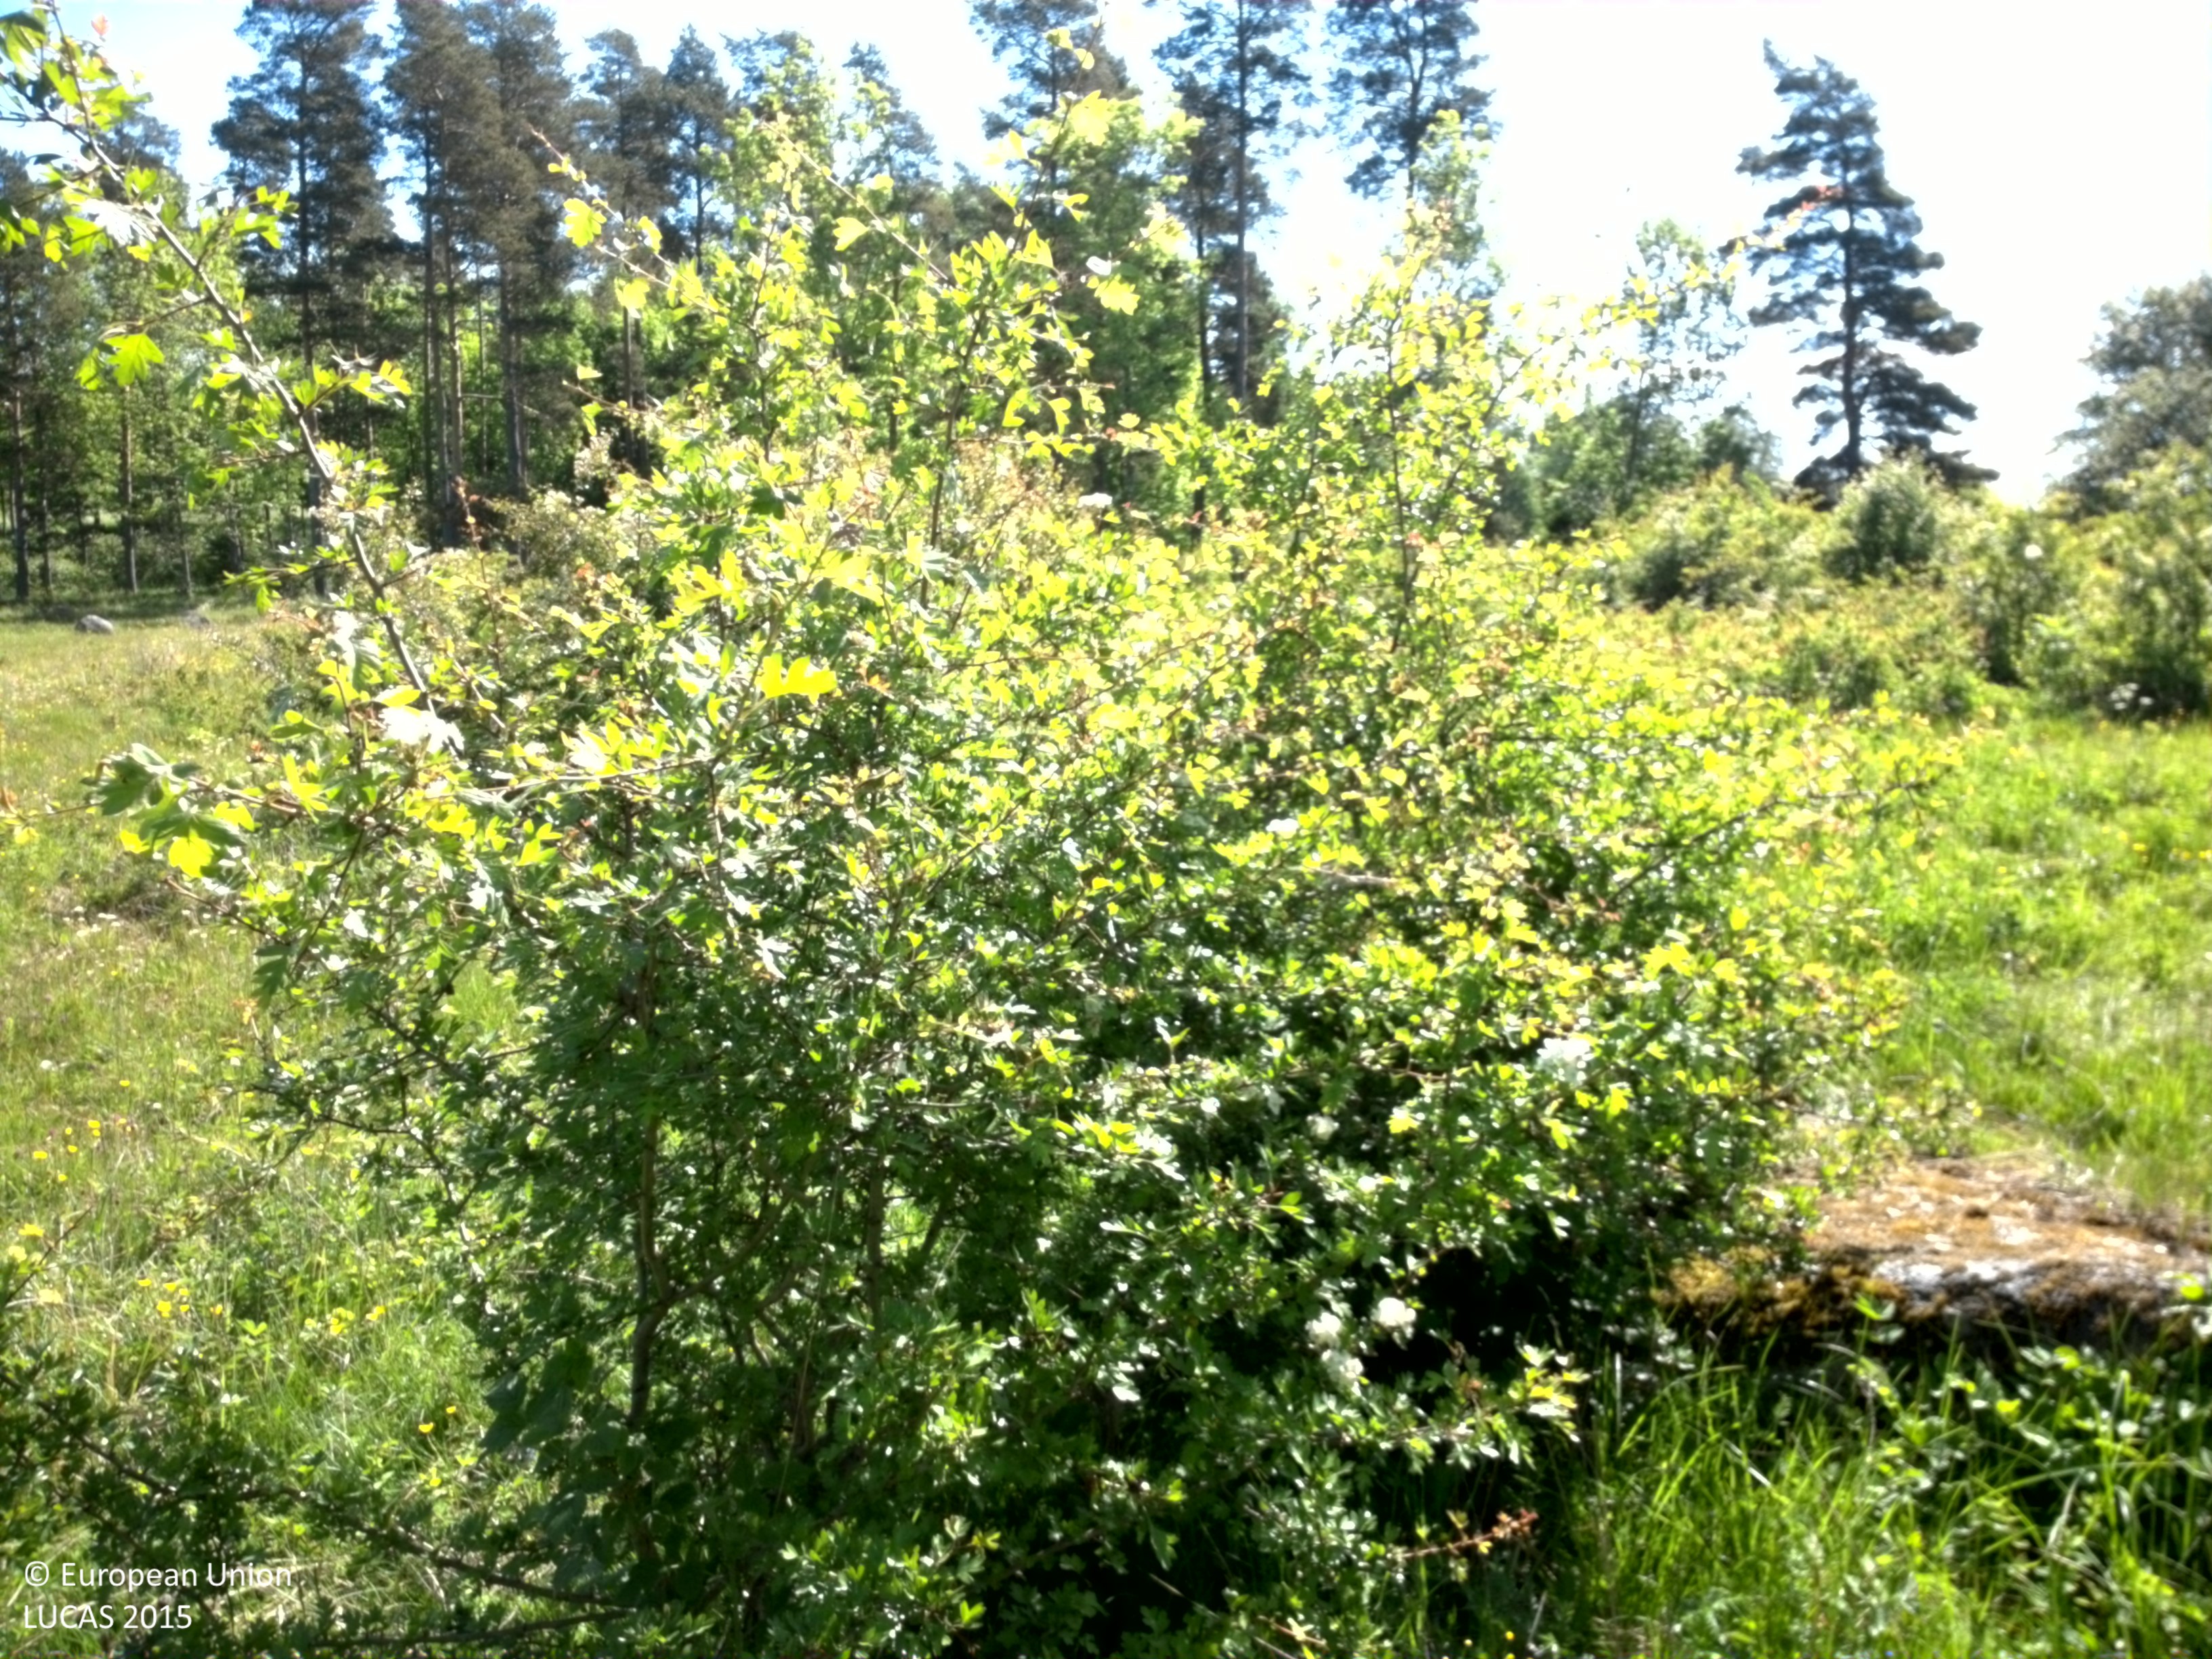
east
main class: Shrubland
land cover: Shrubland with sparse tree cover
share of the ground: 25 - 50 %
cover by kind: herbaceous plants 70 %, shrubs 25 %, broadleaved forest trees 5 %
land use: Agriculture (excluding fallow land and kitchen gardens)
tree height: > 5 m
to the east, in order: Shrubland with sparse tree cover; Electric lines; Shrubland without tree cover; Other mixed woodland; Tracks; Other mixed woodland; Dry stone walls; Broadleaved woodland; Fences; Artificial constructions in urban areas; Fences; Broadleaved woodland; Grassland with sparse tree/shrub cover
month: June
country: SE
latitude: 58.4706
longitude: 15.4291
